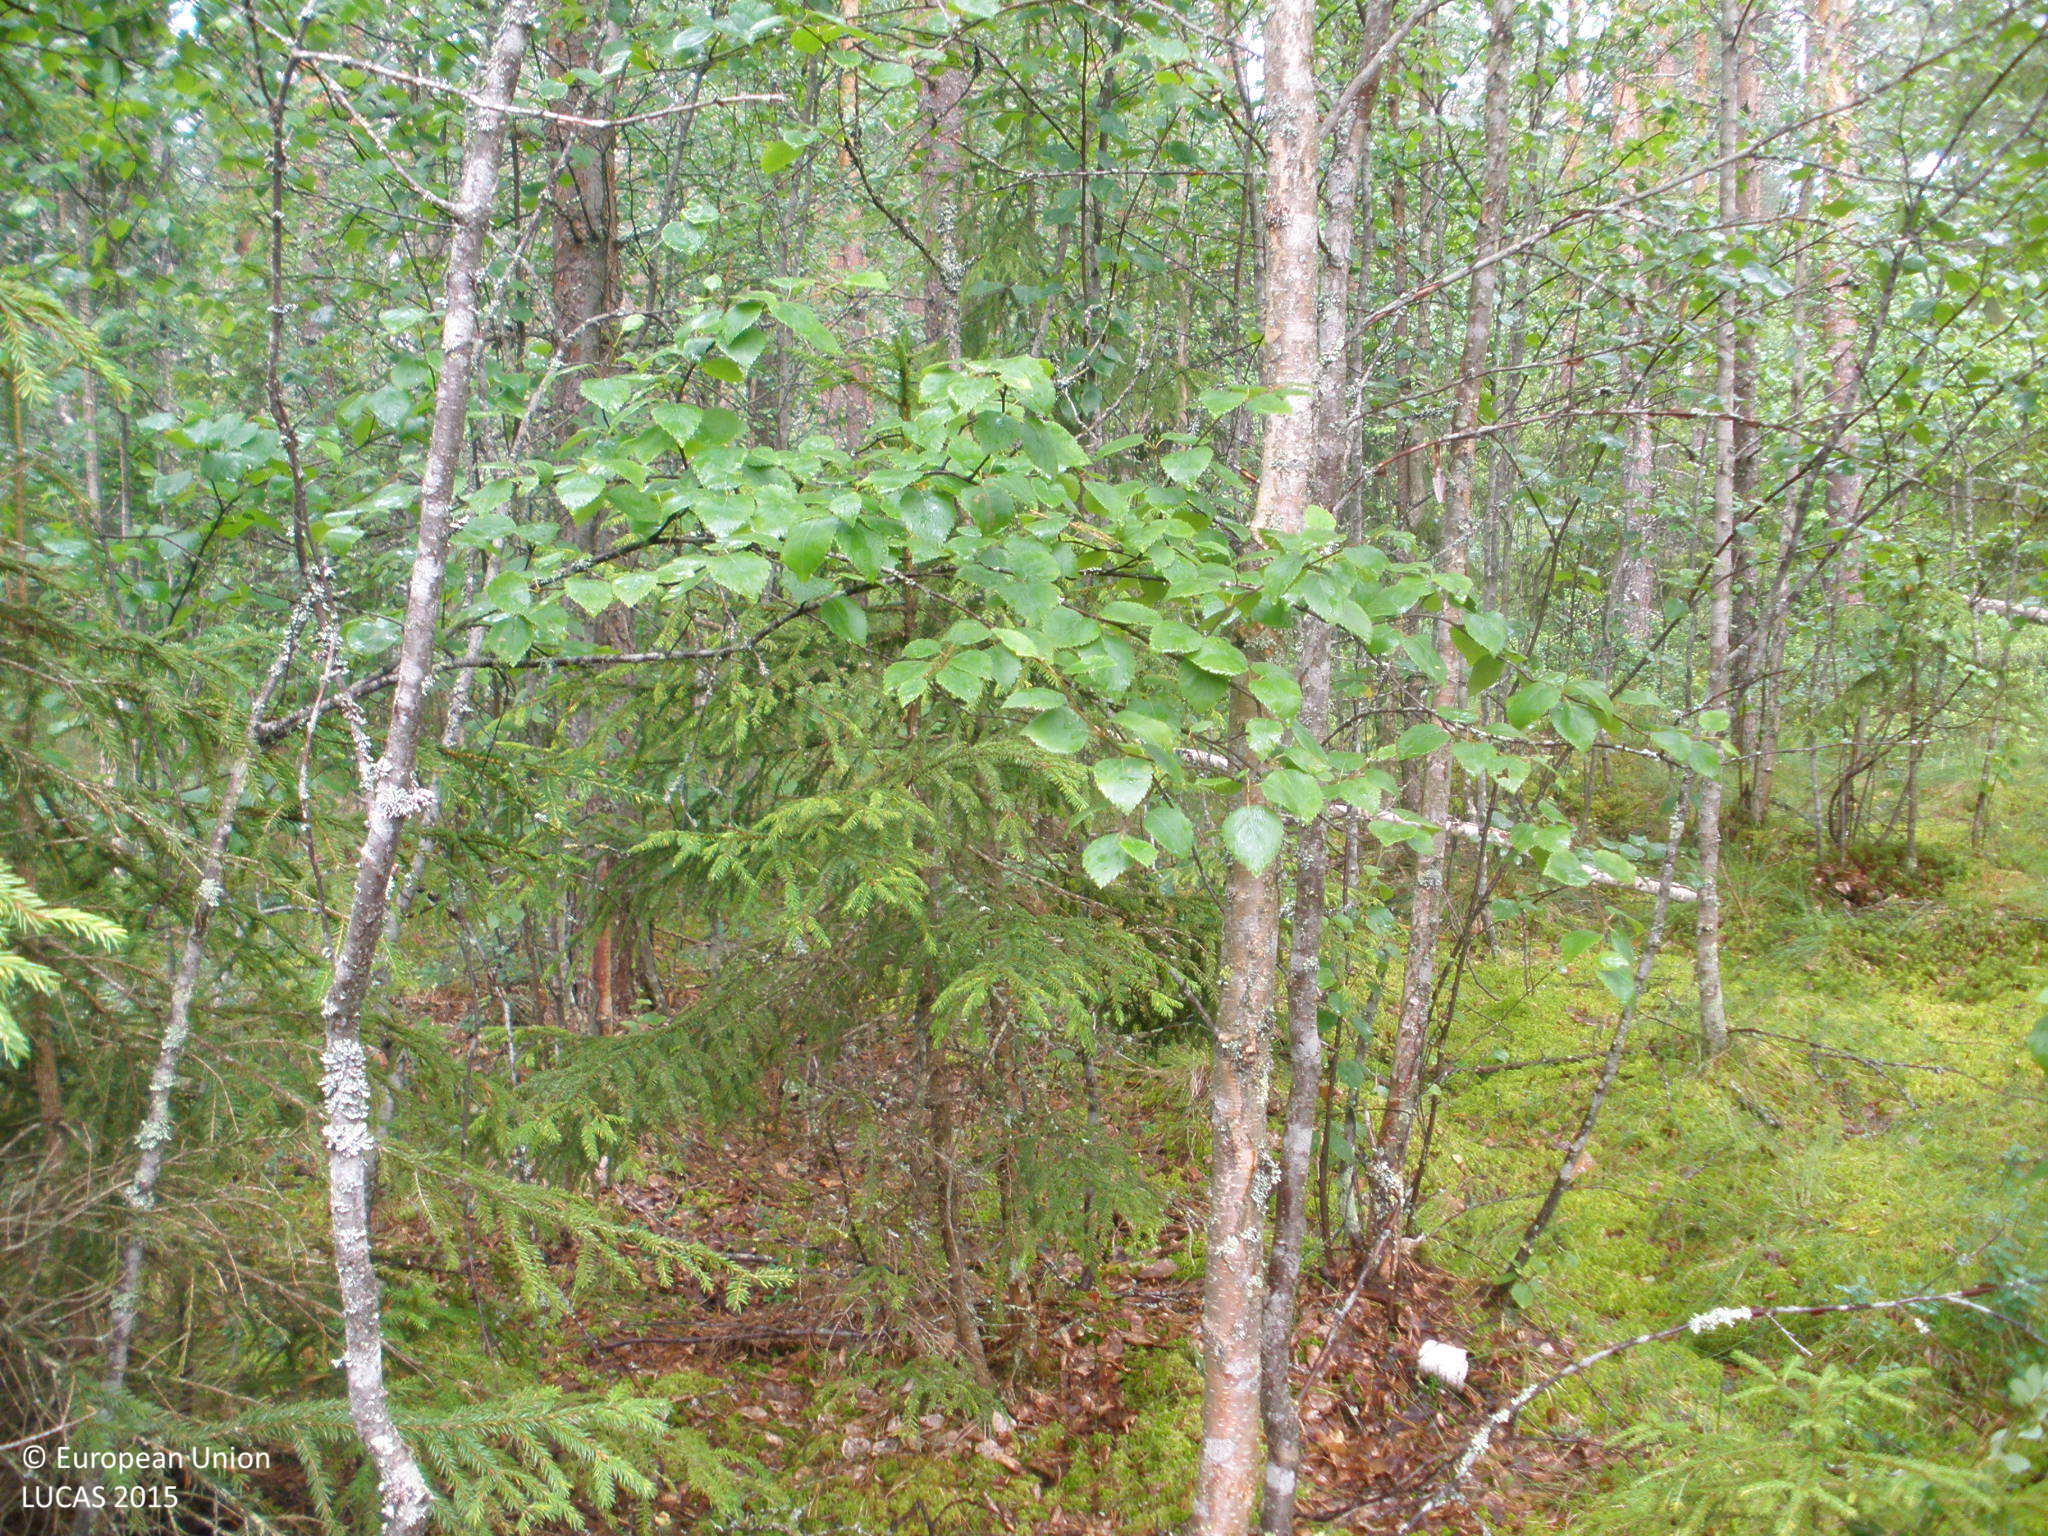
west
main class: Woodland
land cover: Pine dominated mixed woodland
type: boreal forest
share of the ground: > 75 %
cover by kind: coniferous forest trees 60 %, broadleaved forest trees 25 %, lichens and mosses 10 %, shrubs 5 %
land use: Forestry
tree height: > 5 m
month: July
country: FI
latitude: 61.0290
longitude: 24.9744
